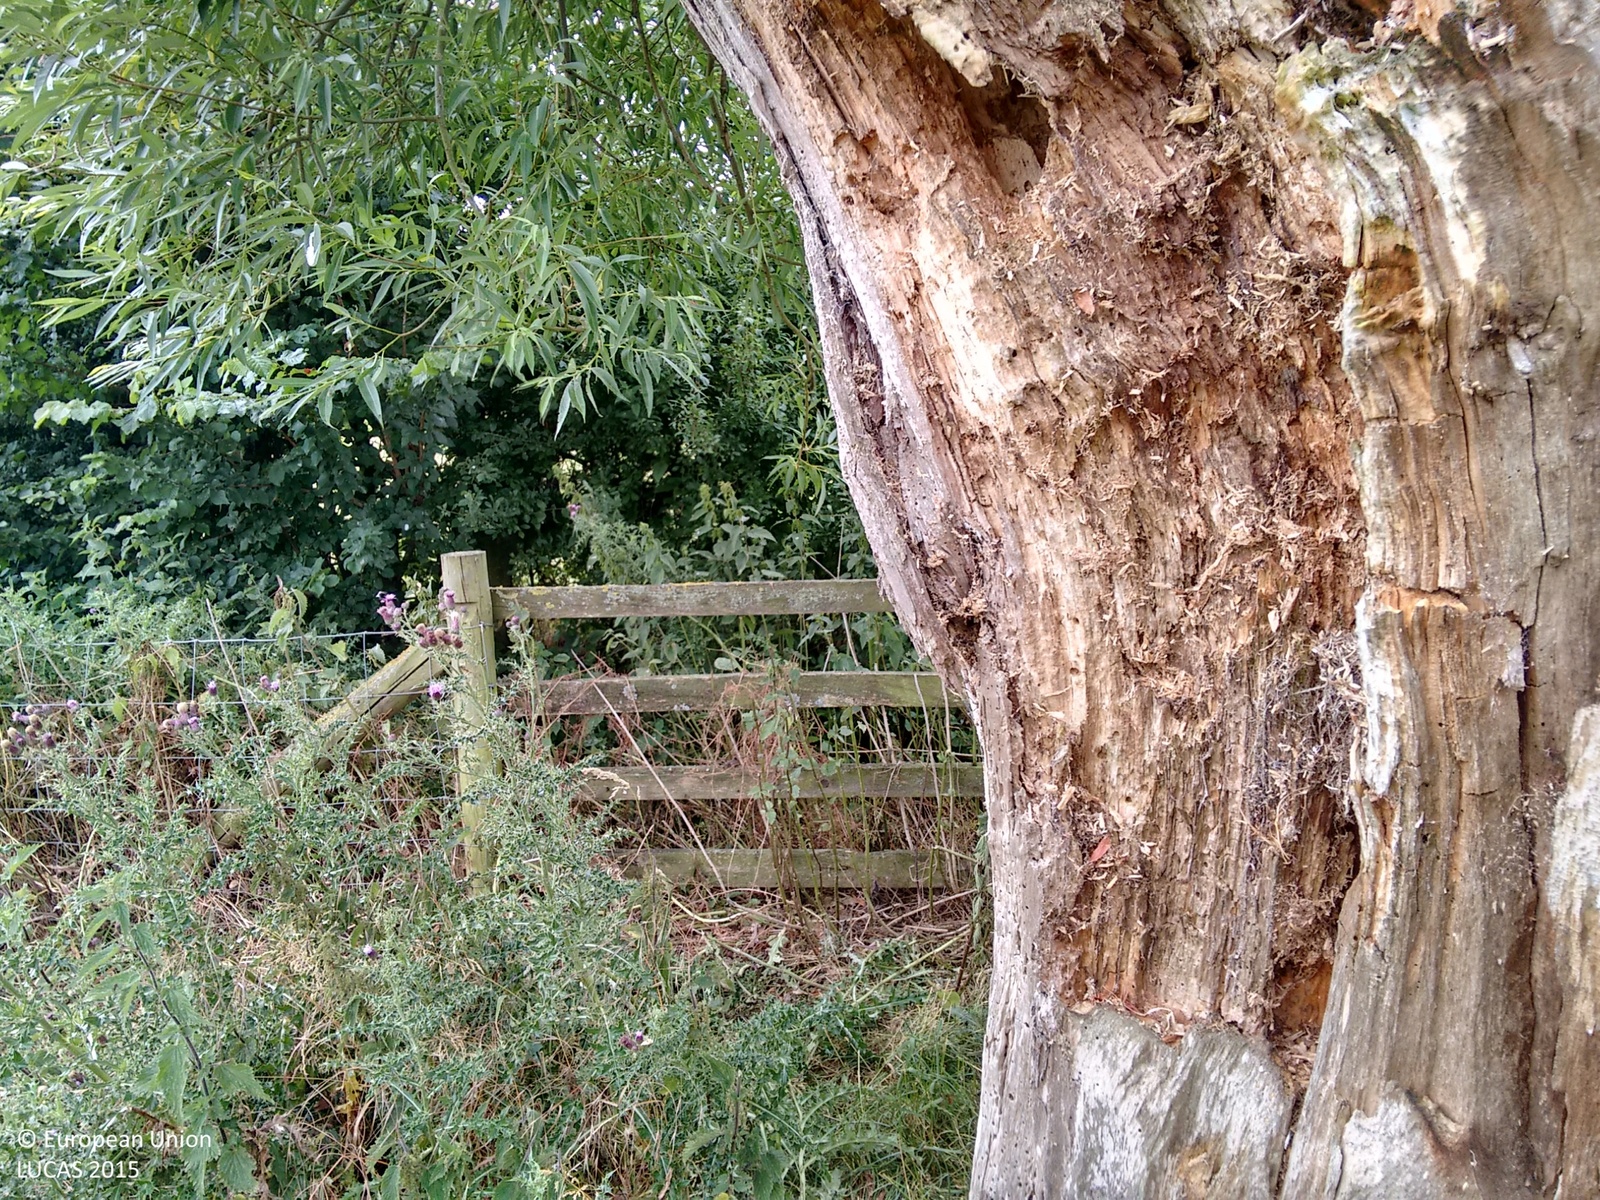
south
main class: Grassland
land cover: Grassland without tree/shrub cover
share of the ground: > 75 %
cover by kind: herbaceous plants 100 %
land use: Agriculture (excluding fallow land and kitchen gardens)
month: July
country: GB
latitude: 52.5062
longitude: -0.9309
